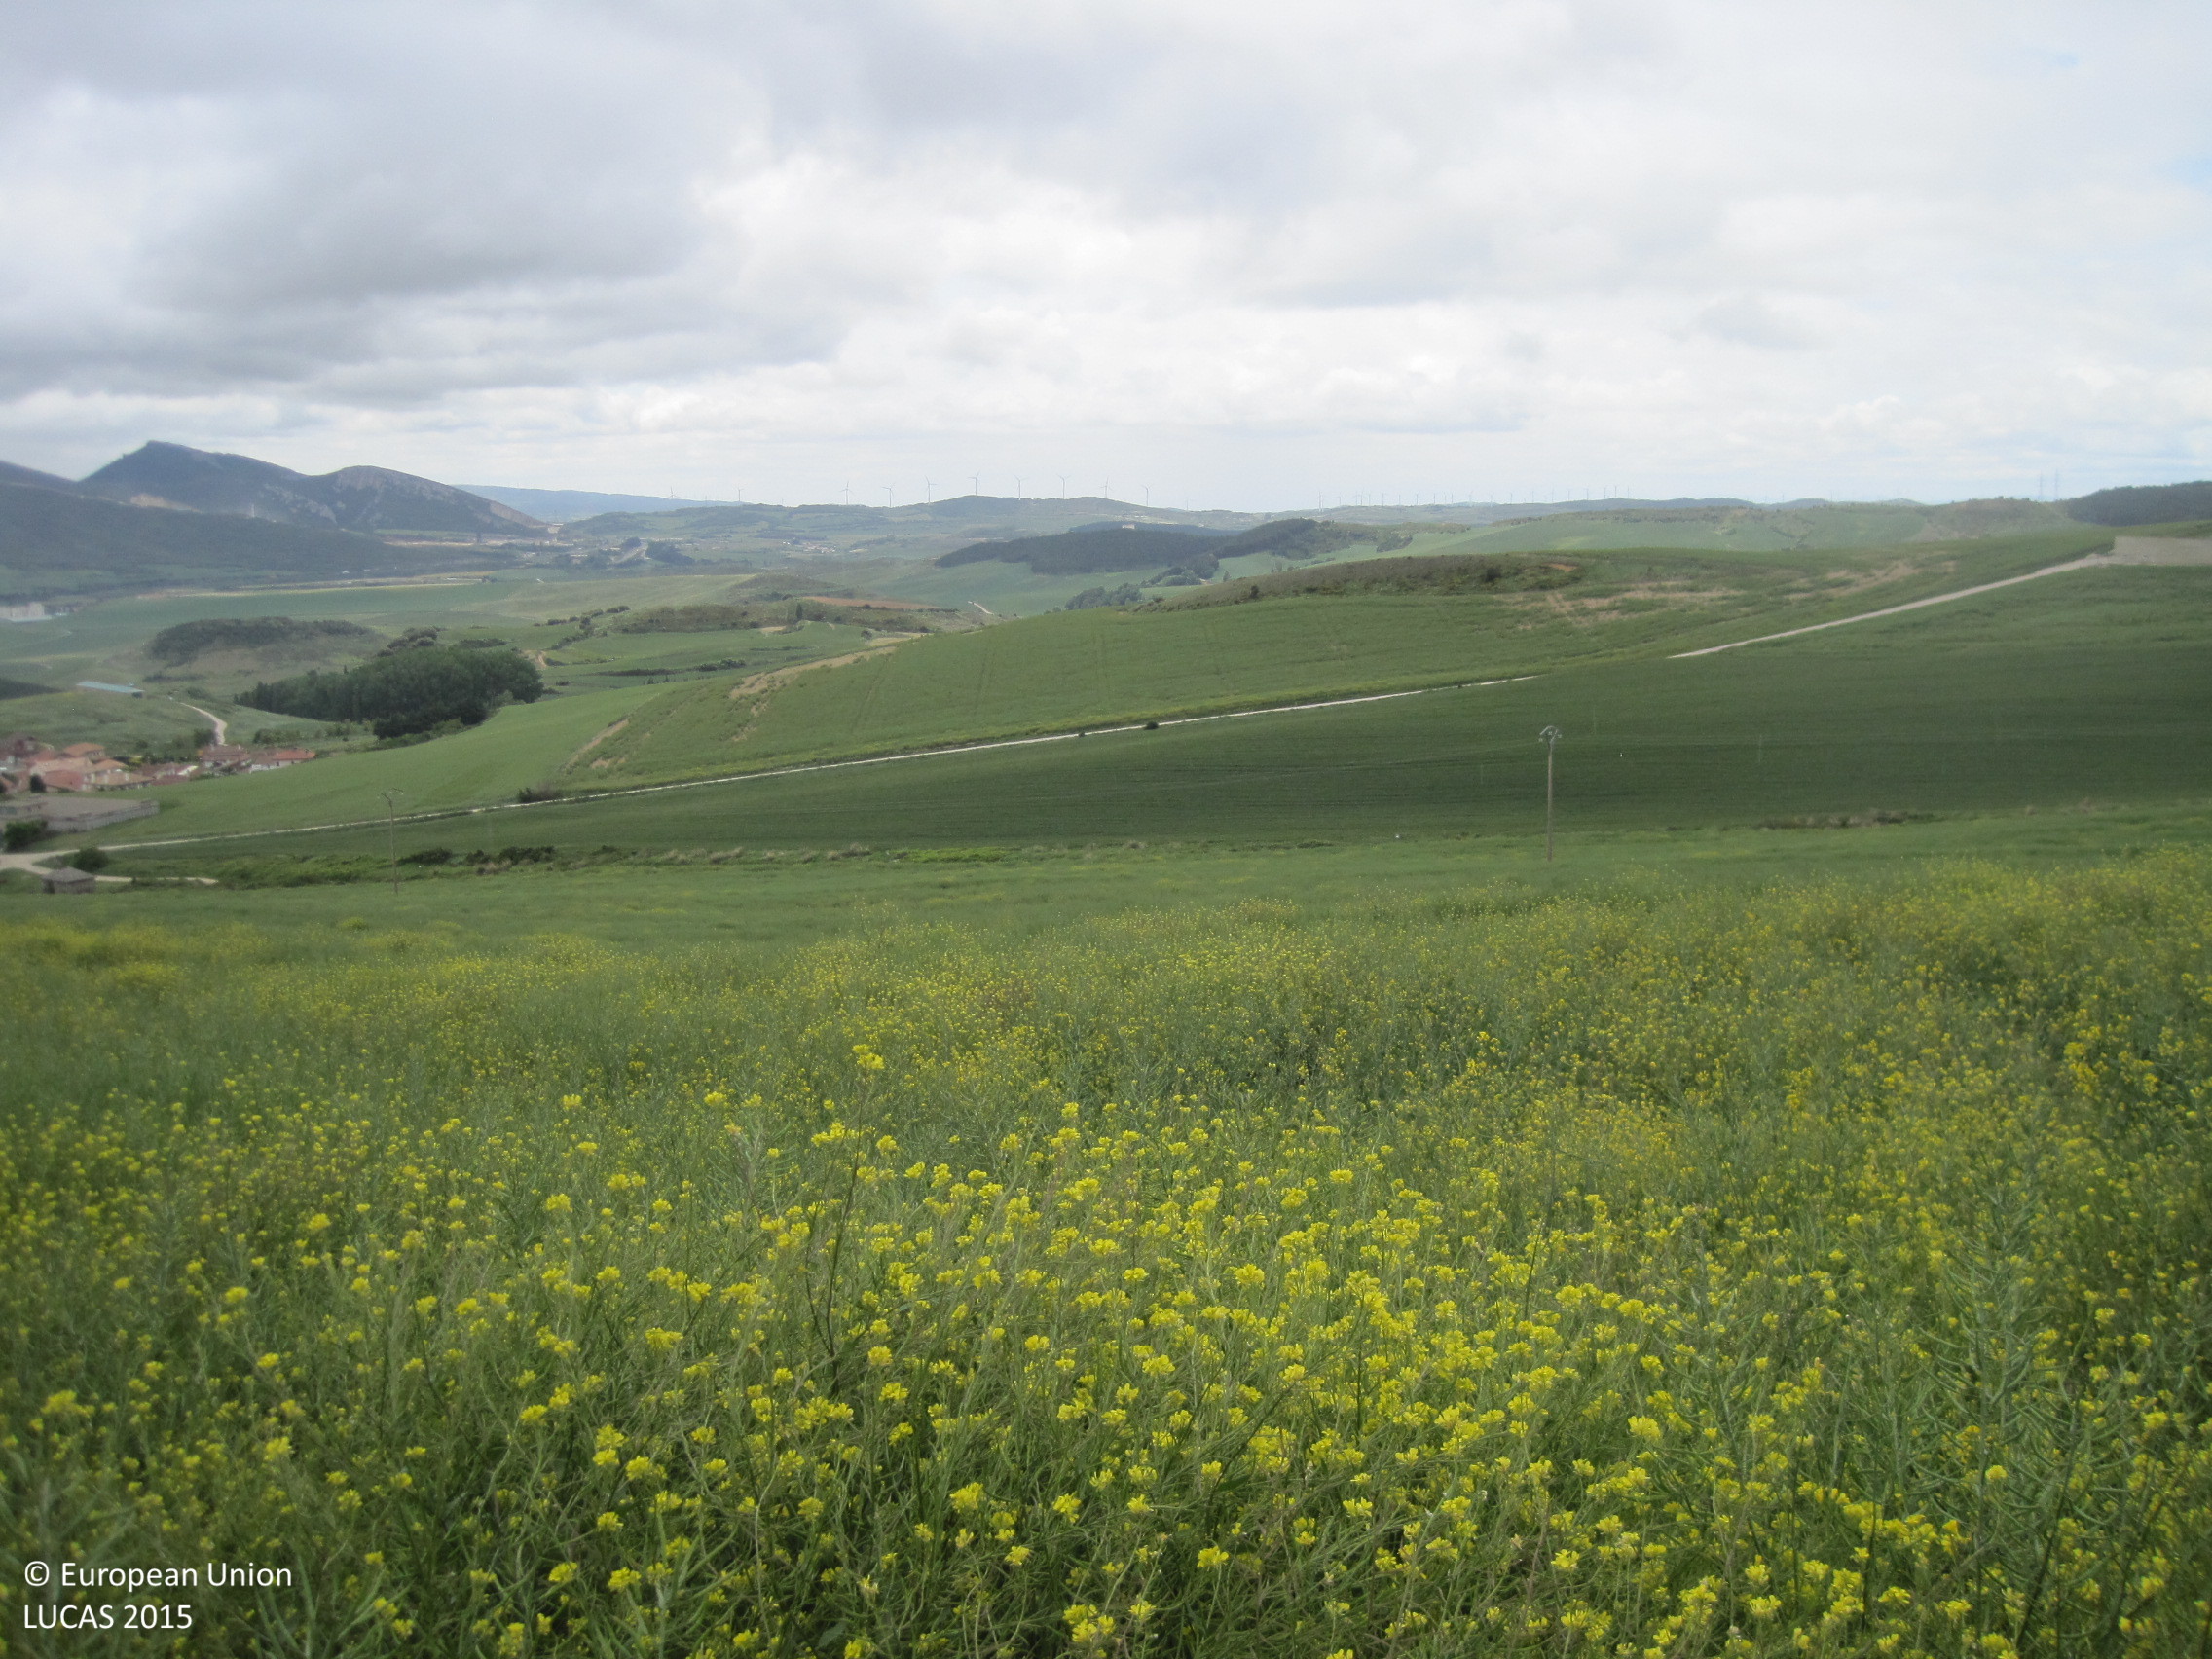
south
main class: Cropland
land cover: Rape and turnip rape
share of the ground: > 75 %
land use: Agriculture (excluding fallow land and kitchen gardens)
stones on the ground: < 10 %
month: May
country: ES
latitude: 42.7235
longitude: -1.6768
